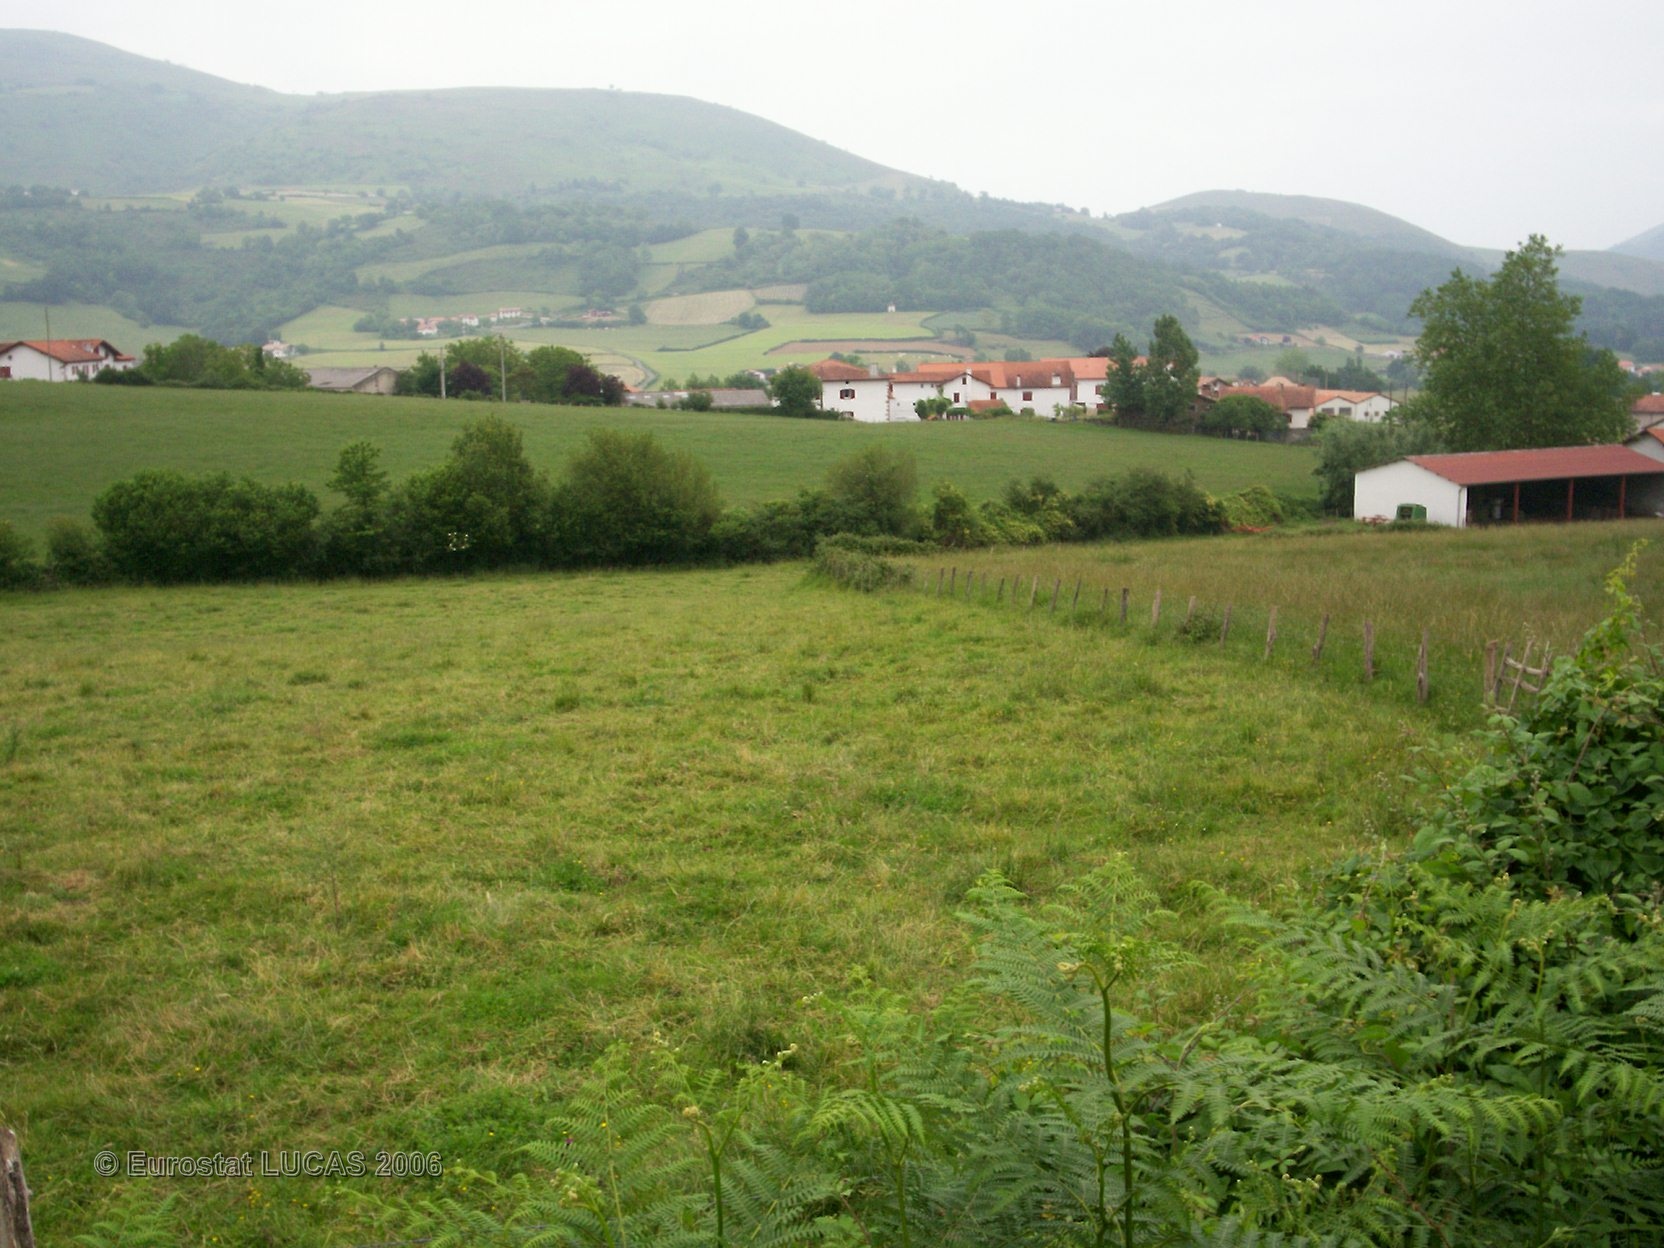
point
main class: Grassland
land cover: Grassland without tree/shrub cover
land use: Agriculture (excluding fallow land and kitchen gardens)
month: May
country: FR
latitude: 43.1677
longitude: -1.2933
